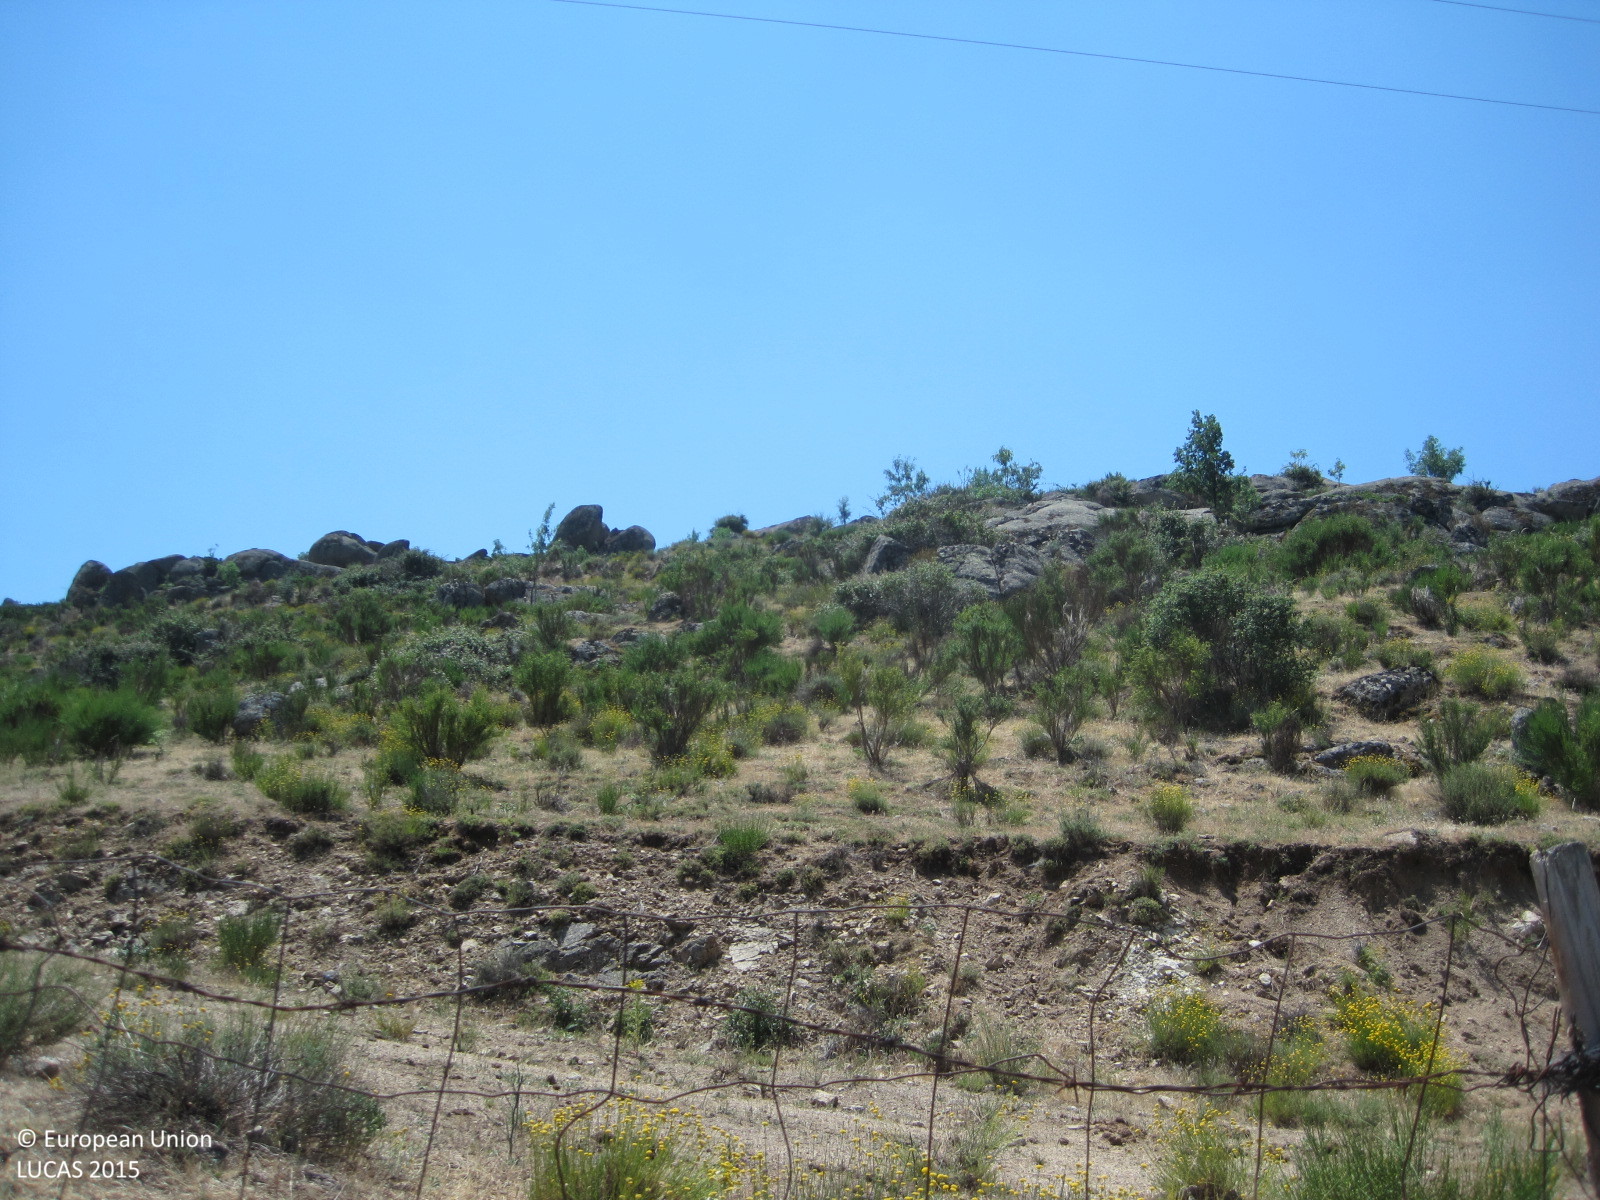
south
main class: Woodland
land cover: Pine dominated coniferous woodland
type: coniferous forest of the mediterranean region
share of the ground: > 75 %
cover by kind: coniferous forest trees 95 %, herbaceous plants 5 %
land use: Forestry
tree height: > 5 m
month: June
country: ES
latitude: 40.4478
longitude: -4.8764
